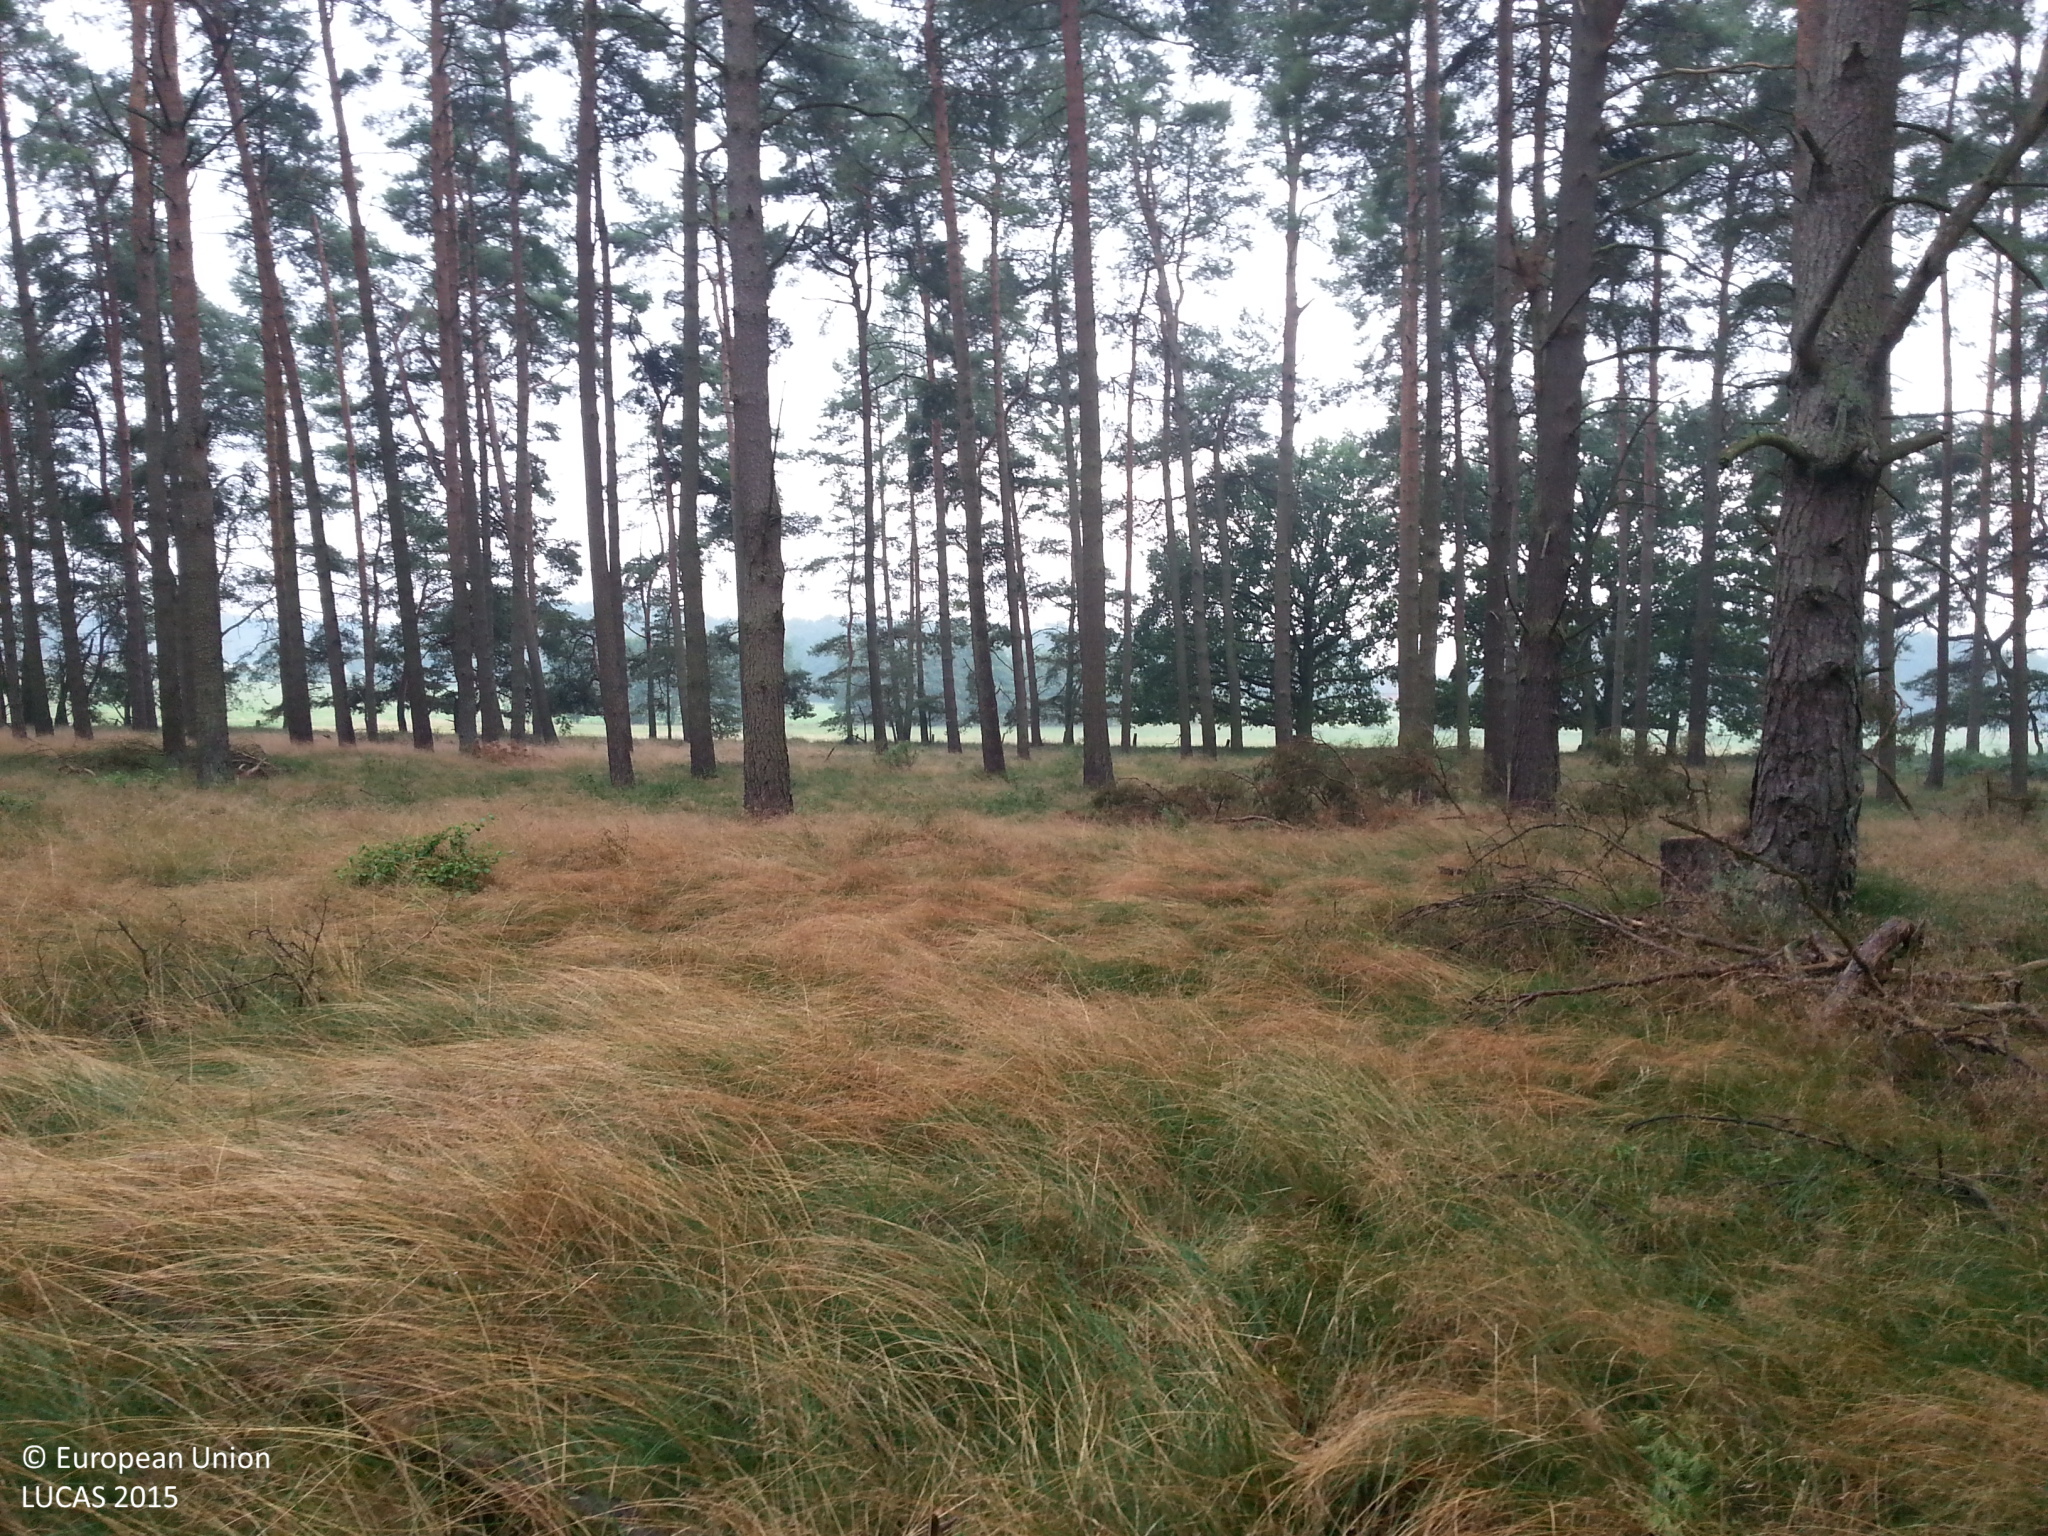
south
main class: Woodland
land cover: Pine dominated coniferous woodland
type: hemiboreal forest and nemoral coniferous forest and mixed broadleaved-coniferous forest
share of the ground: 50 - 75 %
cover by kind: coniferous forest trees 65 %, herbaceous plants 35 %
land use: Forestry
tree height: > 5 m
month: August
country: DE
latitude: 53.1951
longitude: 11.4813
